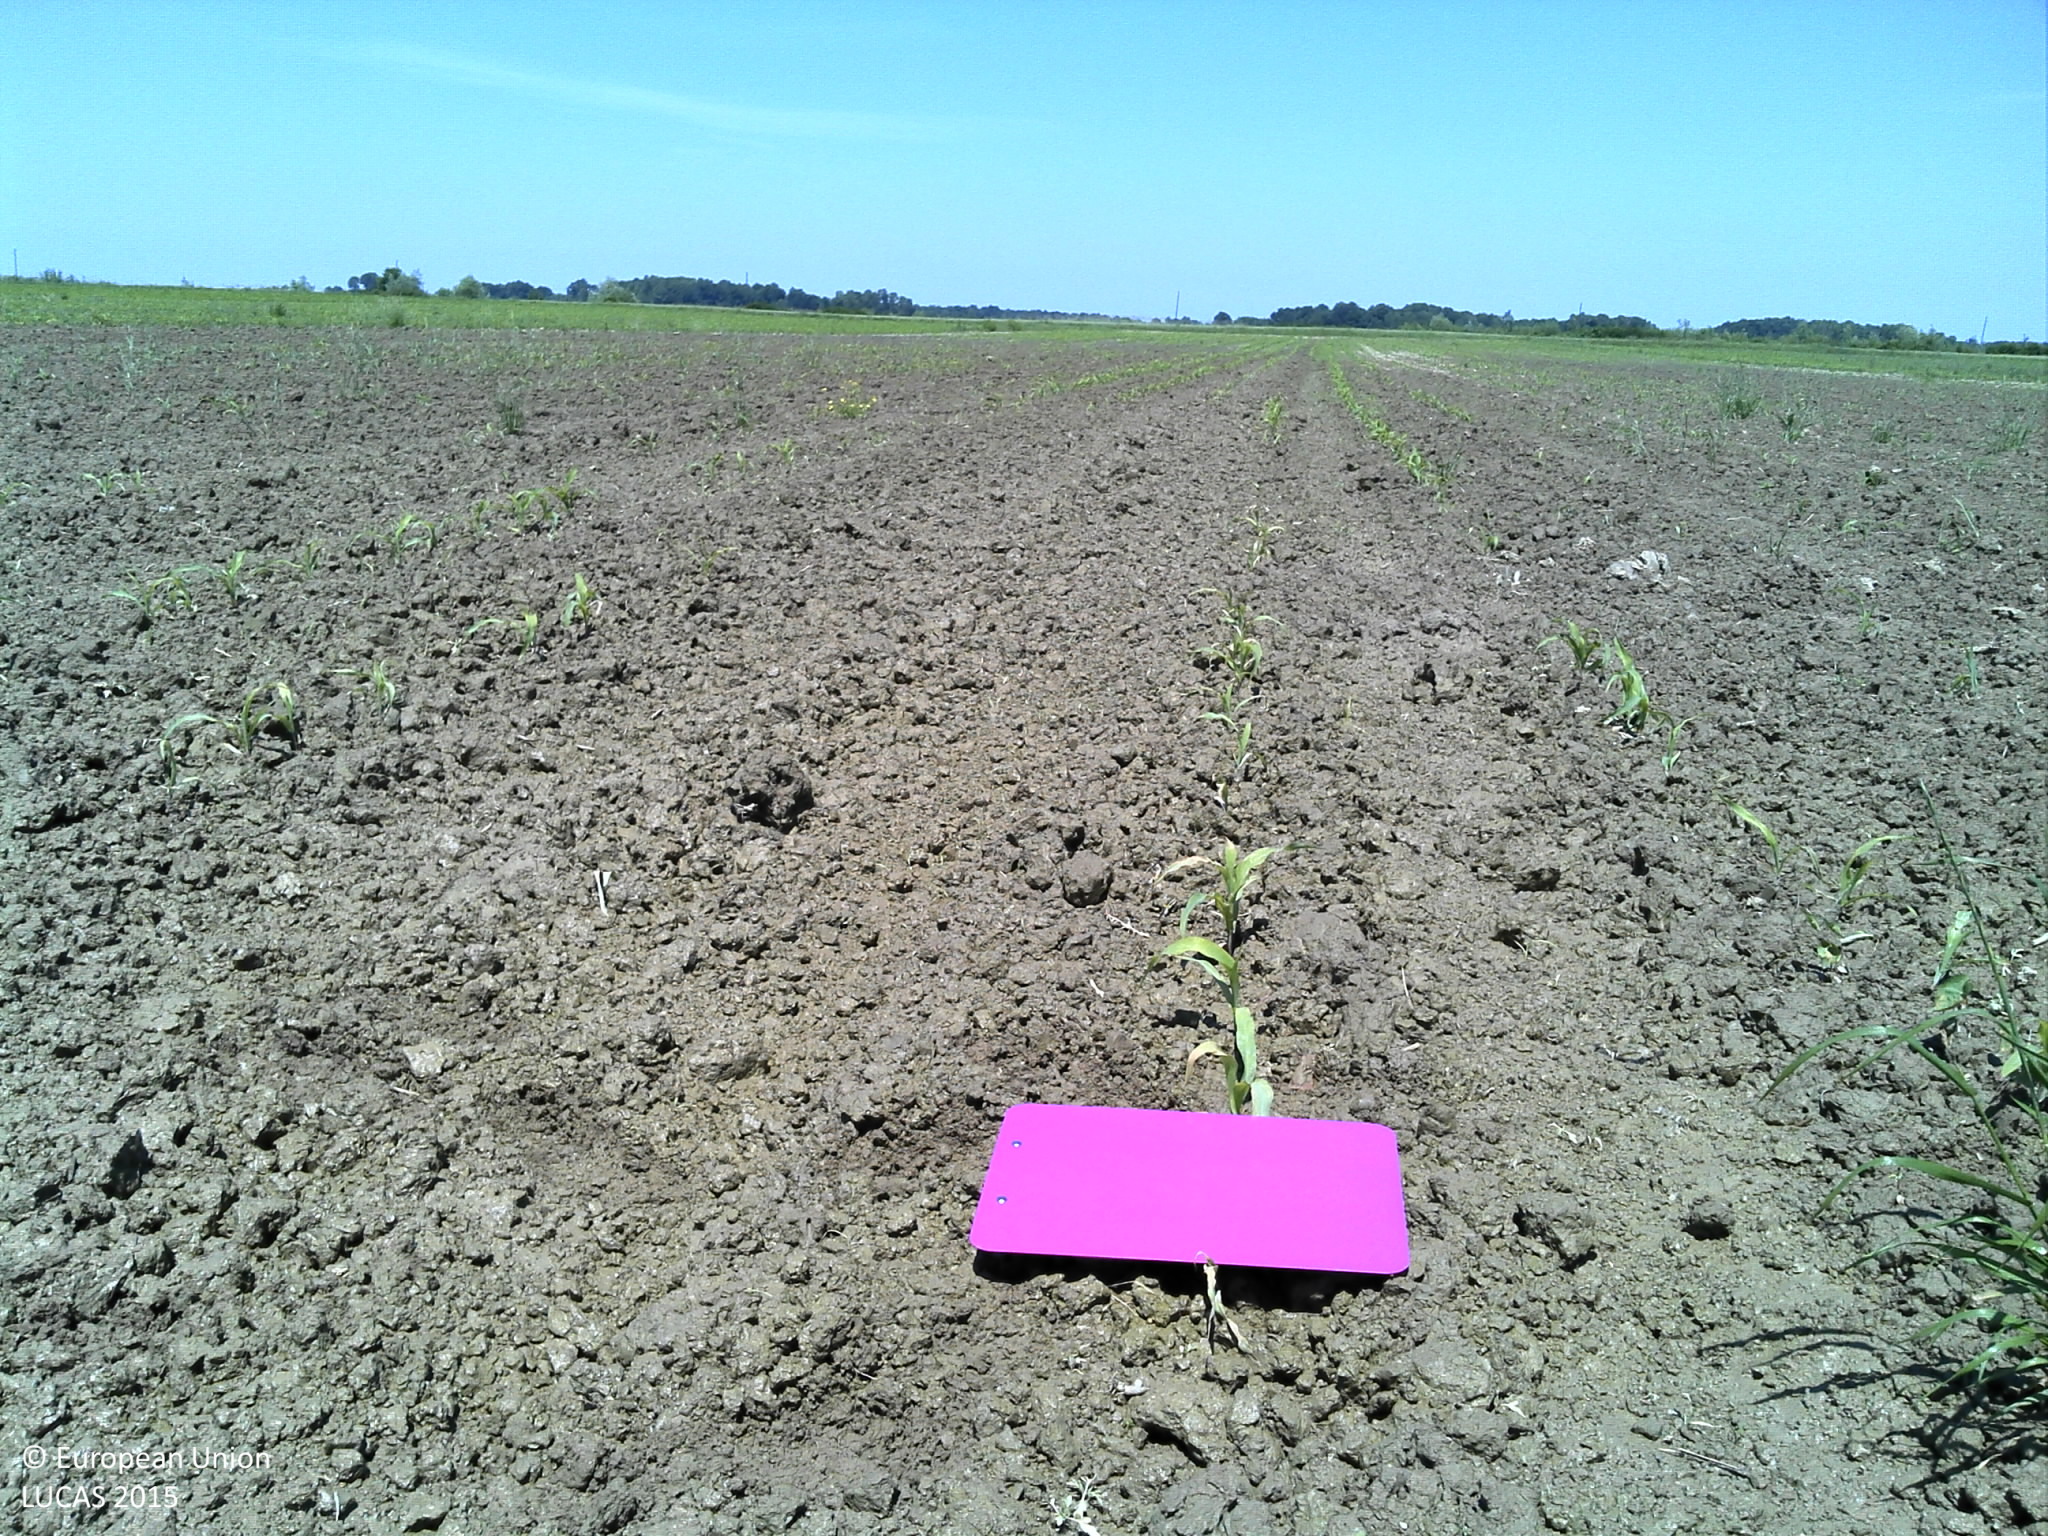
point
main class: Cropland
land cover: Maize
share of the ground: < 10 %
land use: Agriculture (excluding fallow land and kitchen gardens)
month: May
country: HR
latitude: 45.6193
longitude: 17.9682
